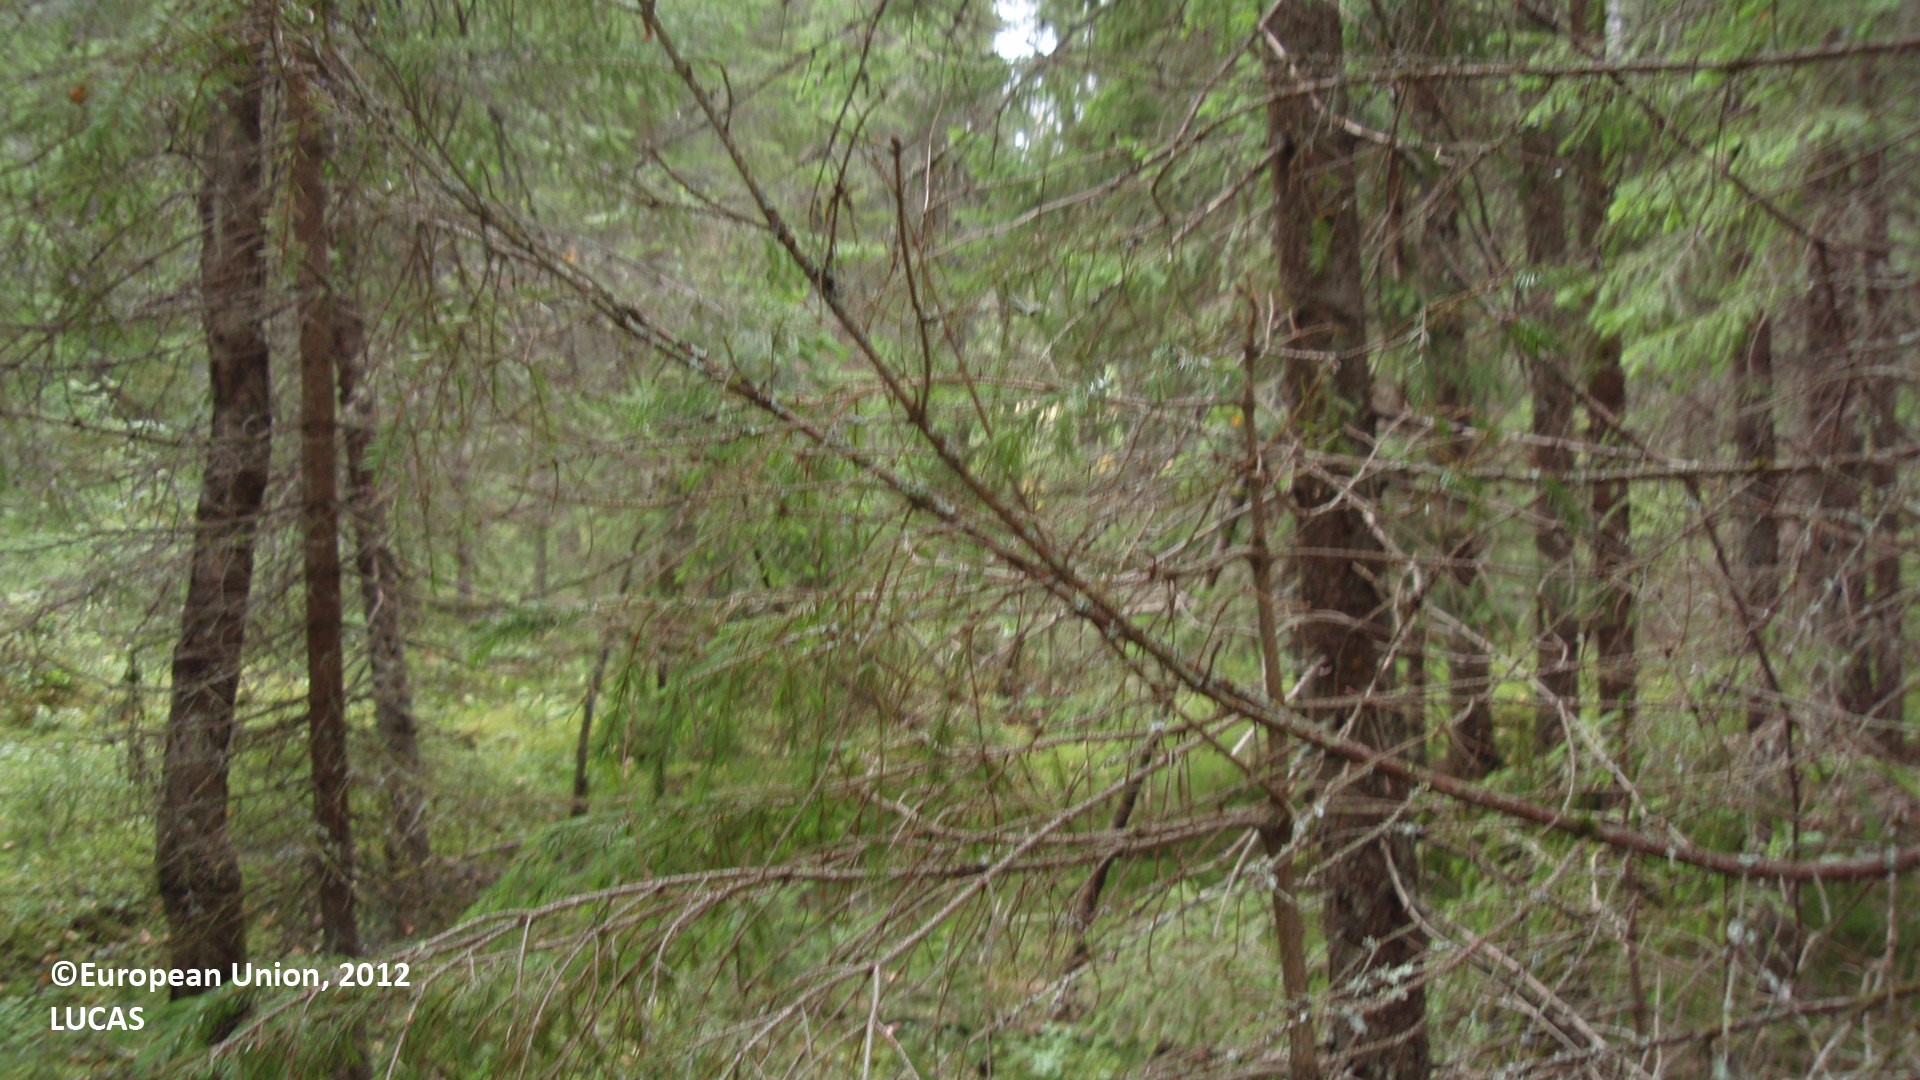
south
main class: Woodland
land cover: Spruce dominated coniferous woodland
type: boreal forest
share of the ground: 50 - 75 %
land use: Forestry
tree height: > 5 m
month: August
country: FI
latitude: 60.8160
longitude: 27.3313
